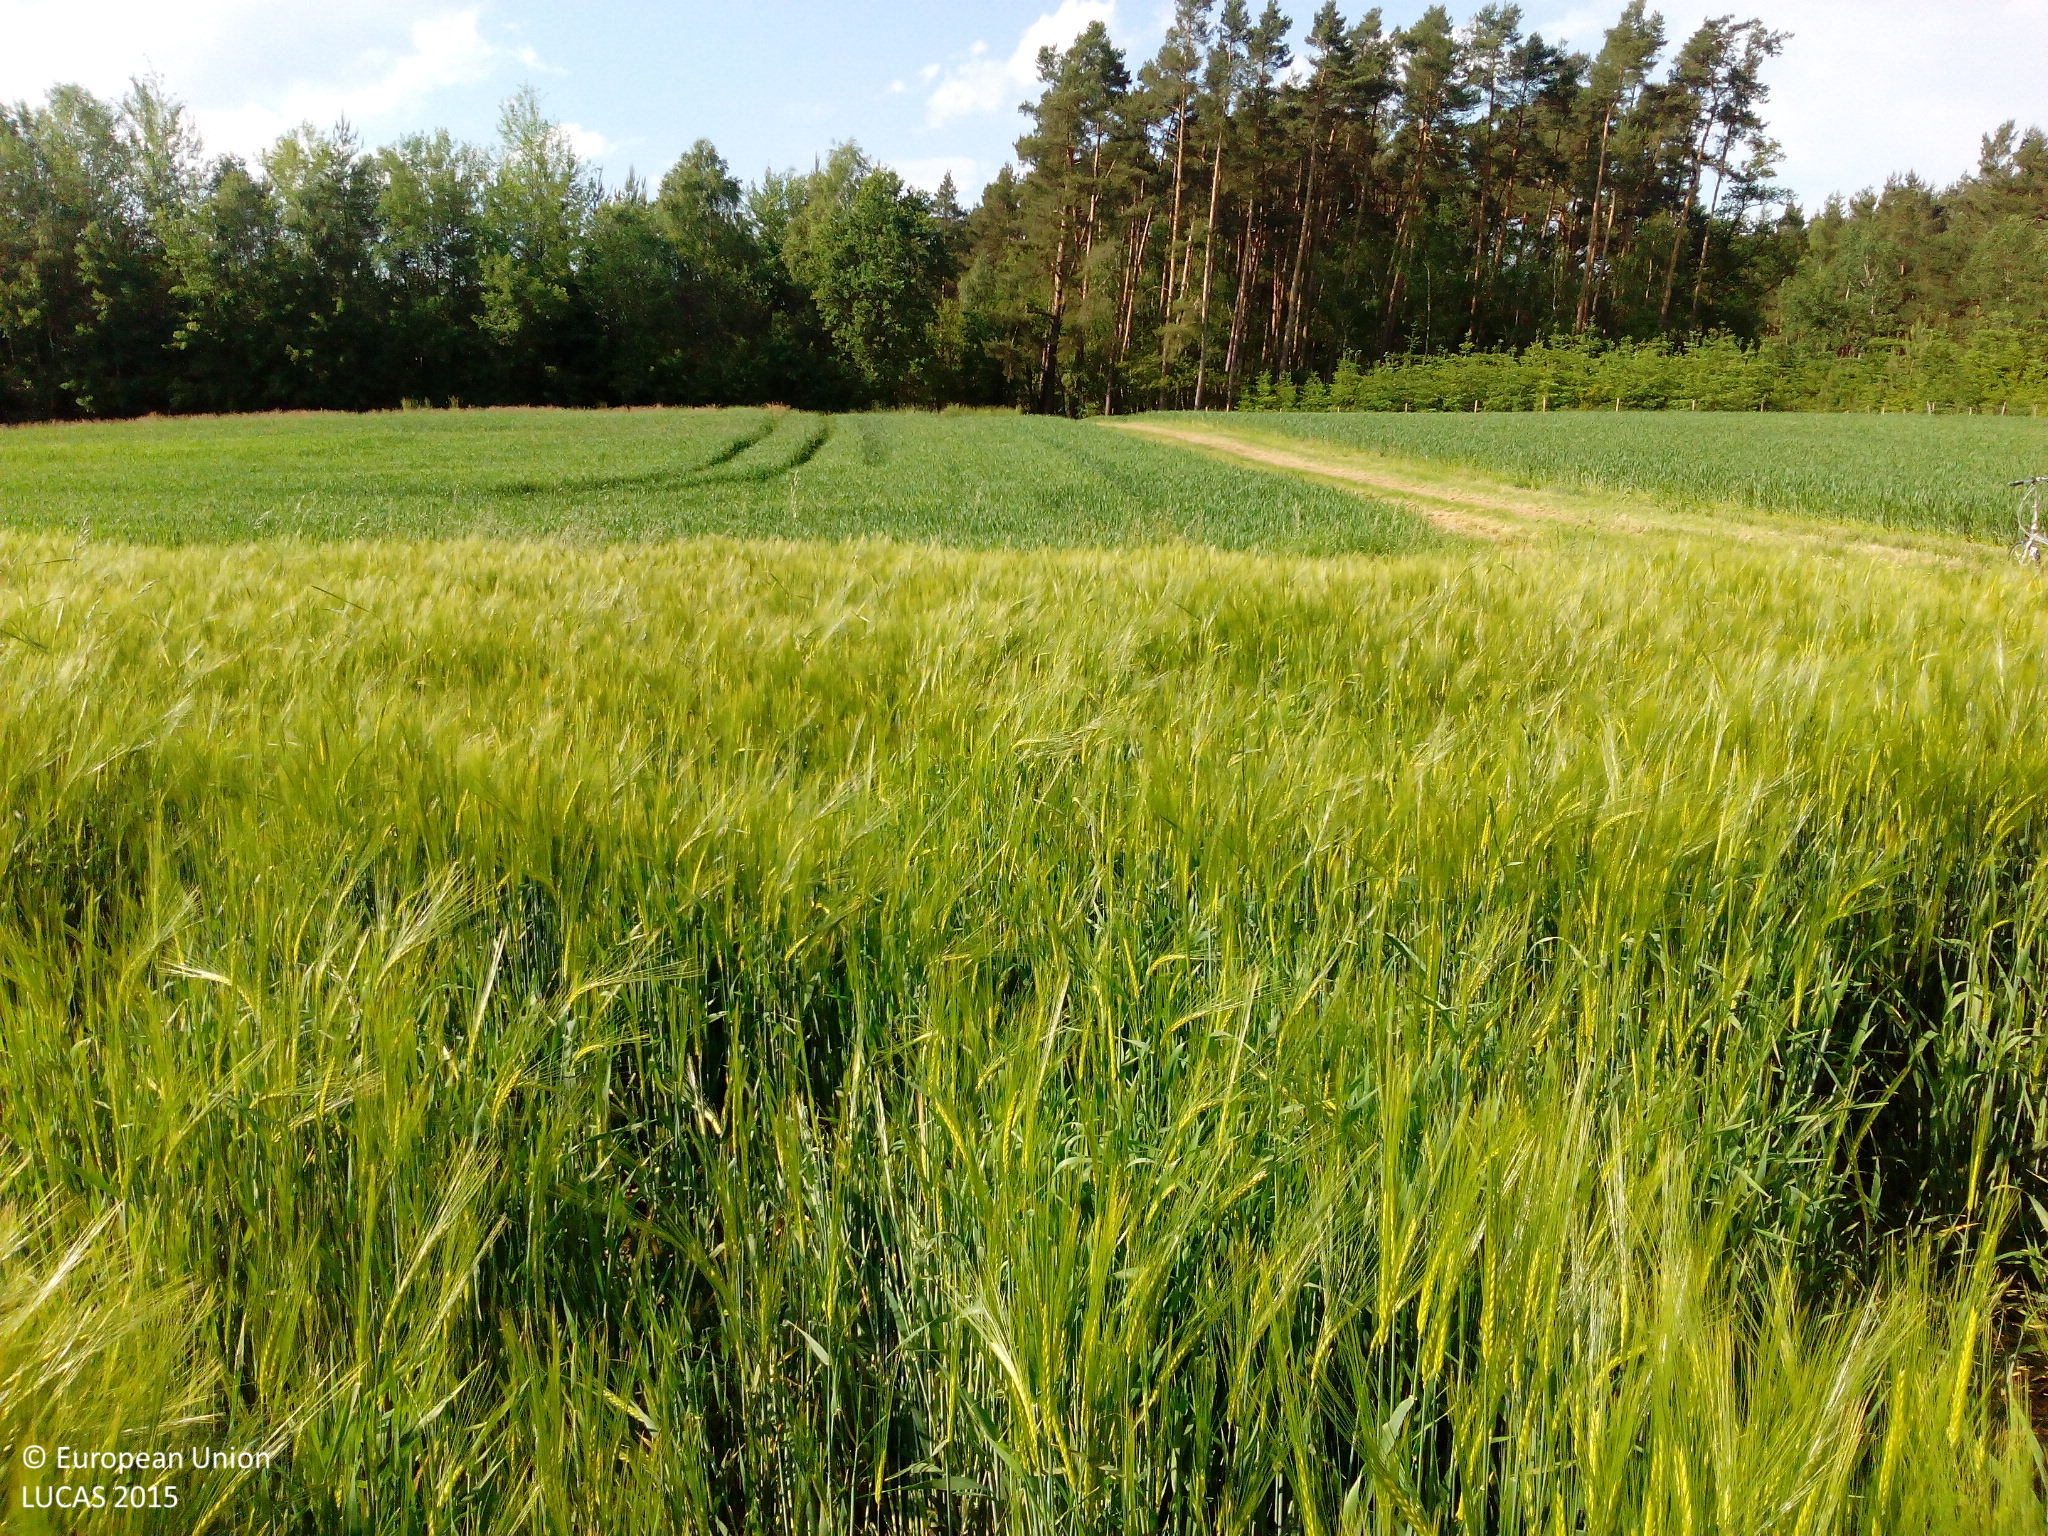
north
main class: Cropland
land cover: Barley
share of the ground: > 75 %
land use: Agriculture (excluding fallow land and kitchen gardens)
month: June
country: DE
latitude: 48.8158
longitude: 12.0829
